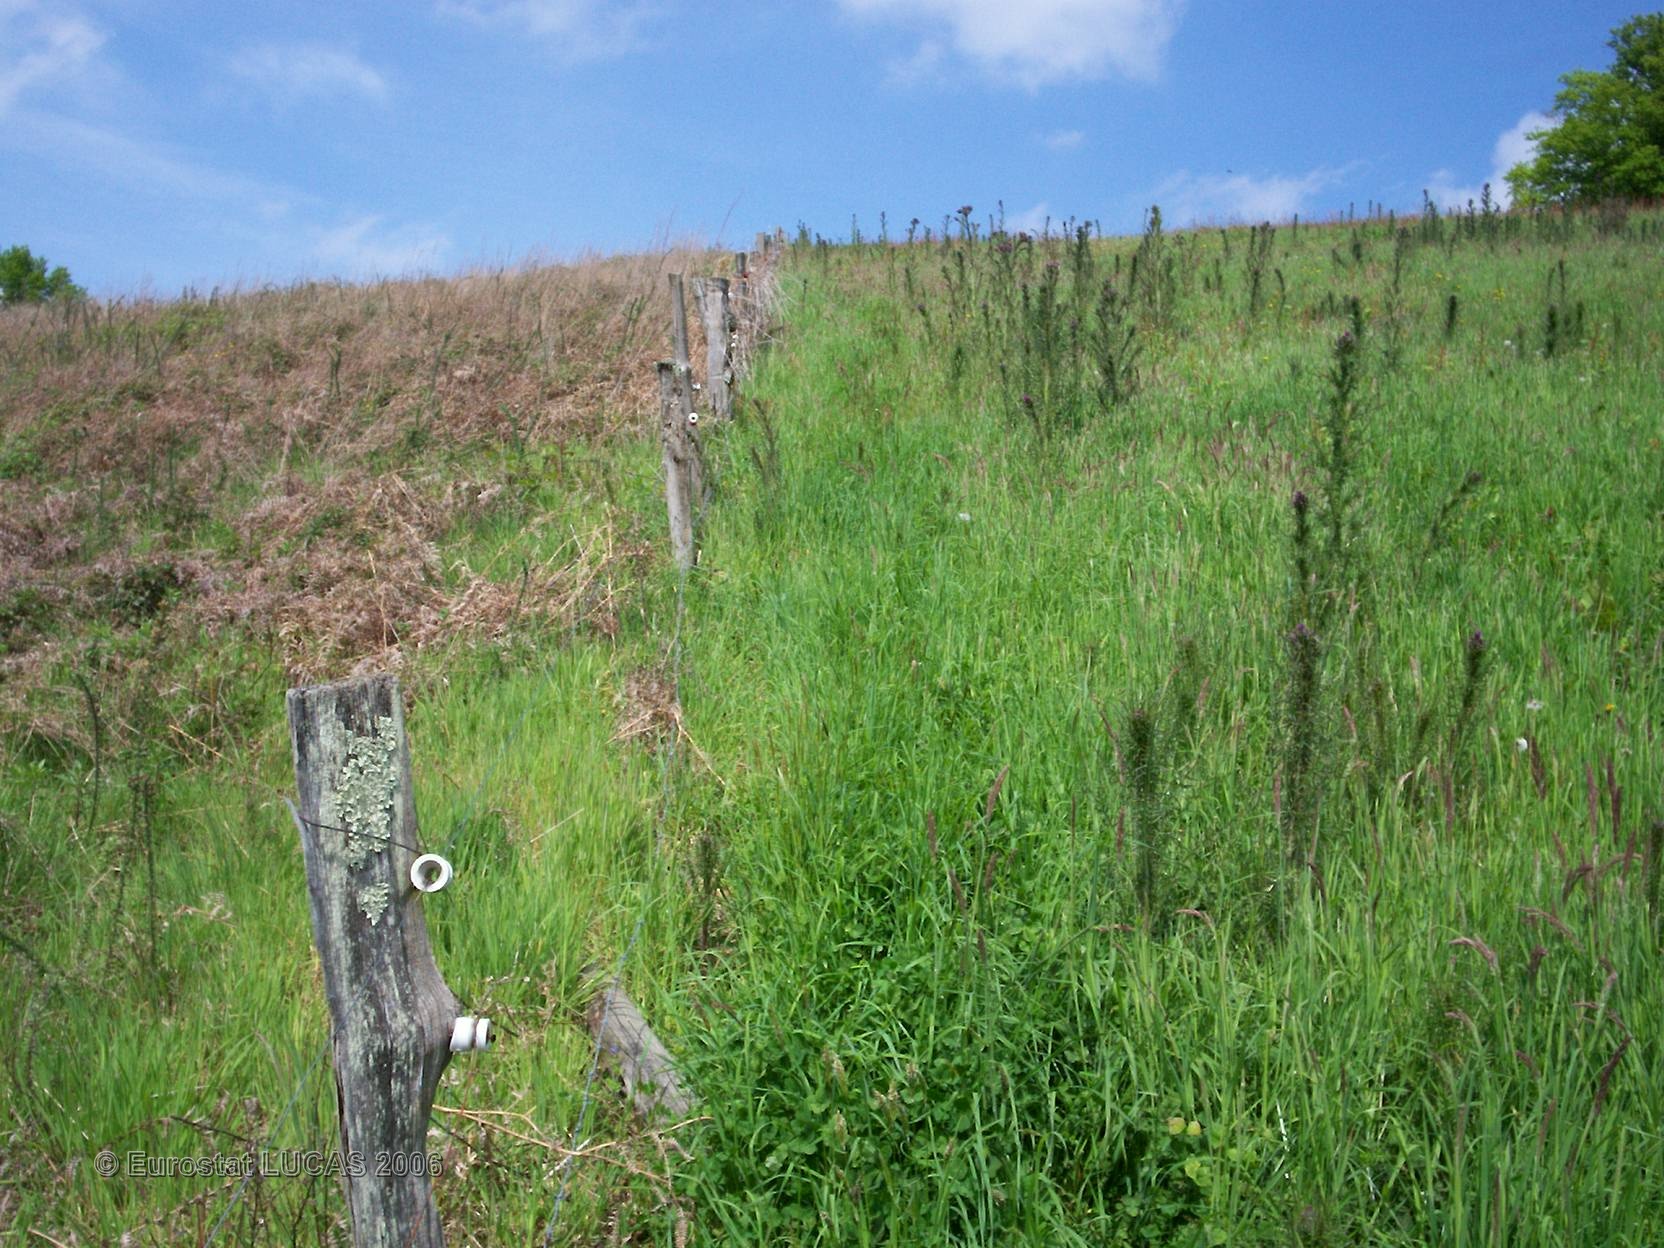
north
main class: Grassland
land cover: Grassland with sparse tree/shrub cover
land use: Fallow land
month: April
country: FR
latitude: 43.2591
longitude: -0.6148
